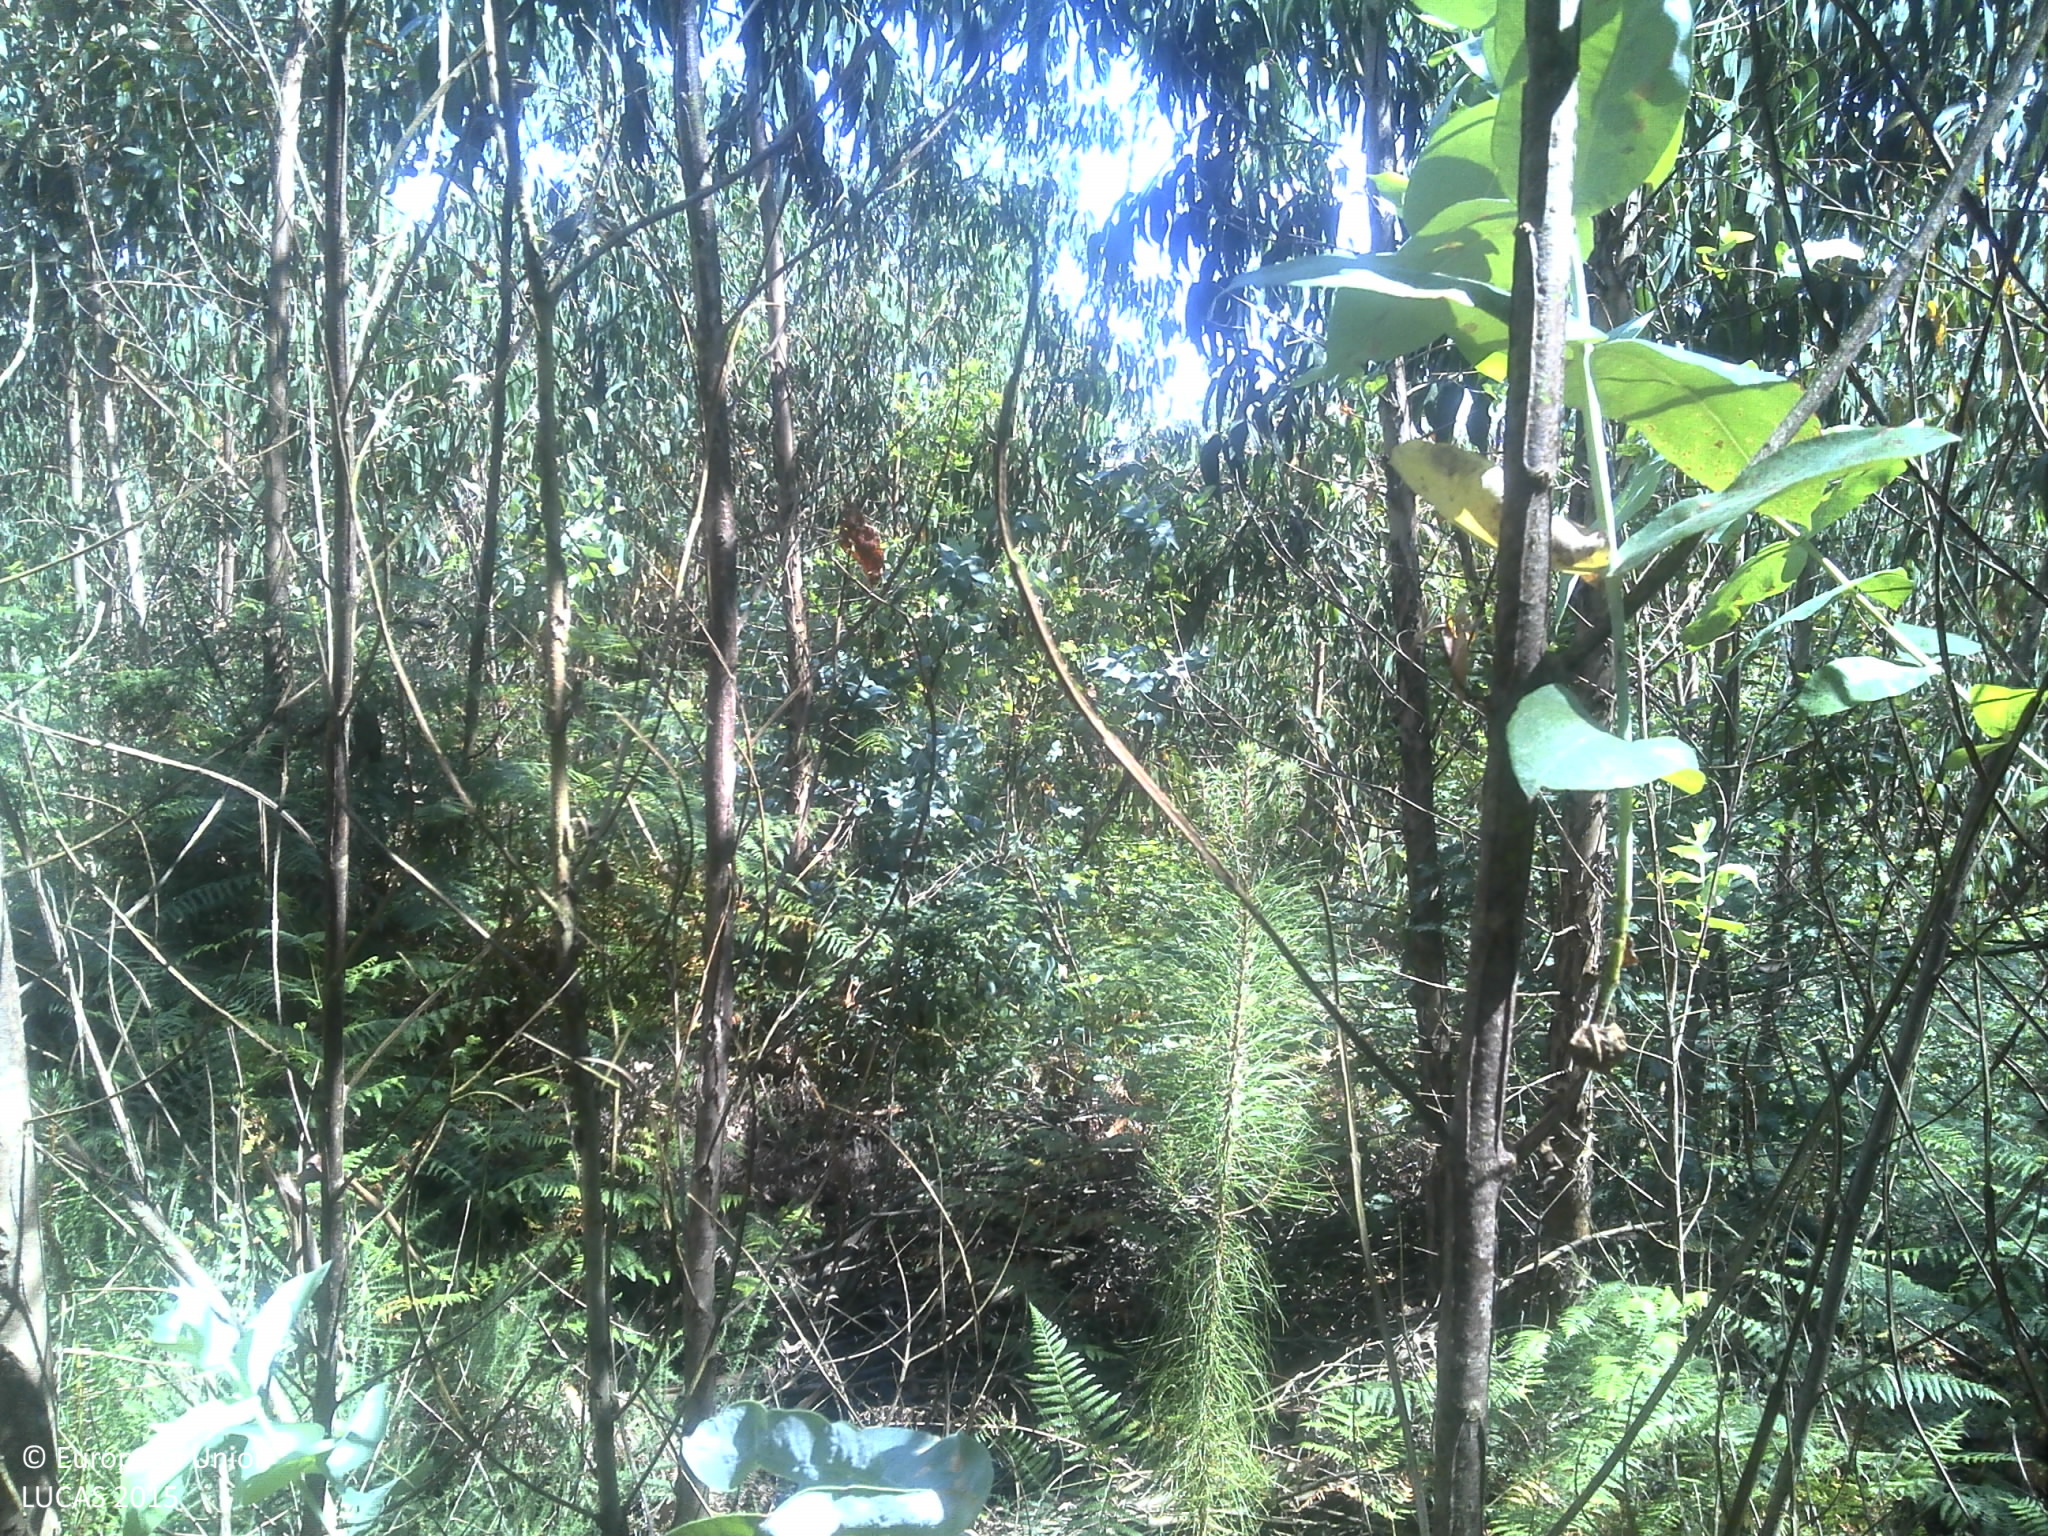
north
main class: Woodland
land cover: Broadleaved woodland
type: exotic forest
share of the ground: > 75 %
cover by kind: broadleaved forest trees 80 %, shrubs 15 %, unconsolidated bare surface 5 %
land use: Forestry
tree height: > 5 m
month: June
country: PT
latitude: 41.6057
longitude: -8.6520
